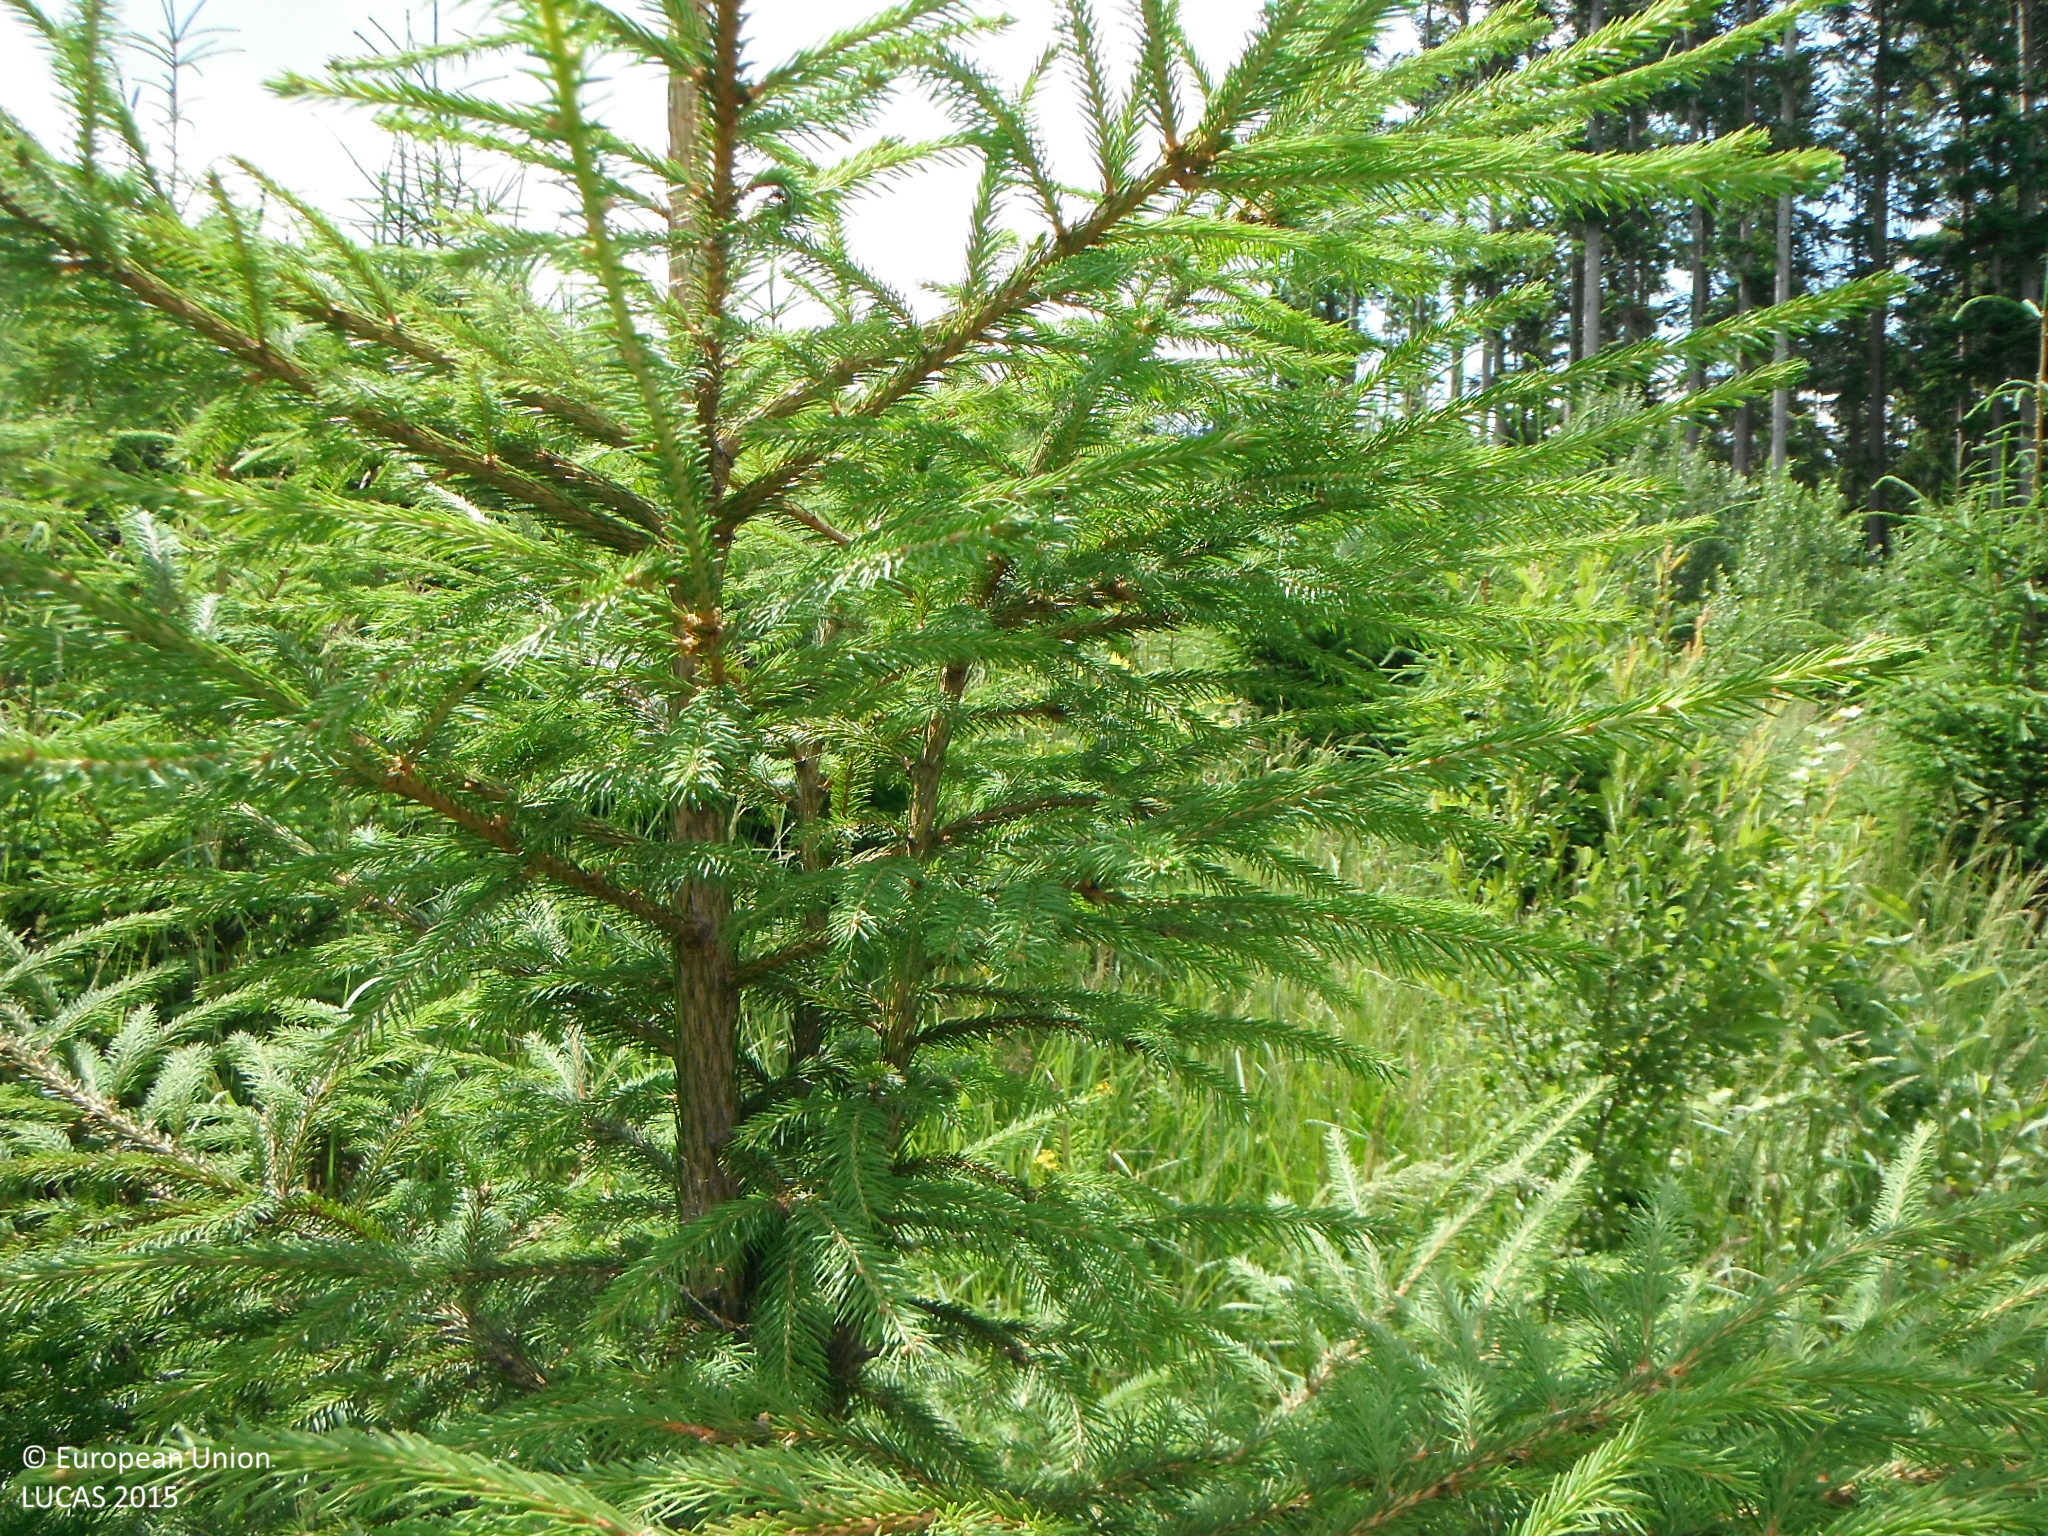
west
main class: Shrubland
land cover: Shrubland without tree cover
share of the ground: > 75 %
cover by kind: shrubs 80 %, herbaceous plants 20 %
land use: Forestry
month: July
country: SK
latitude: 49.3868
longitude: 19.5185
